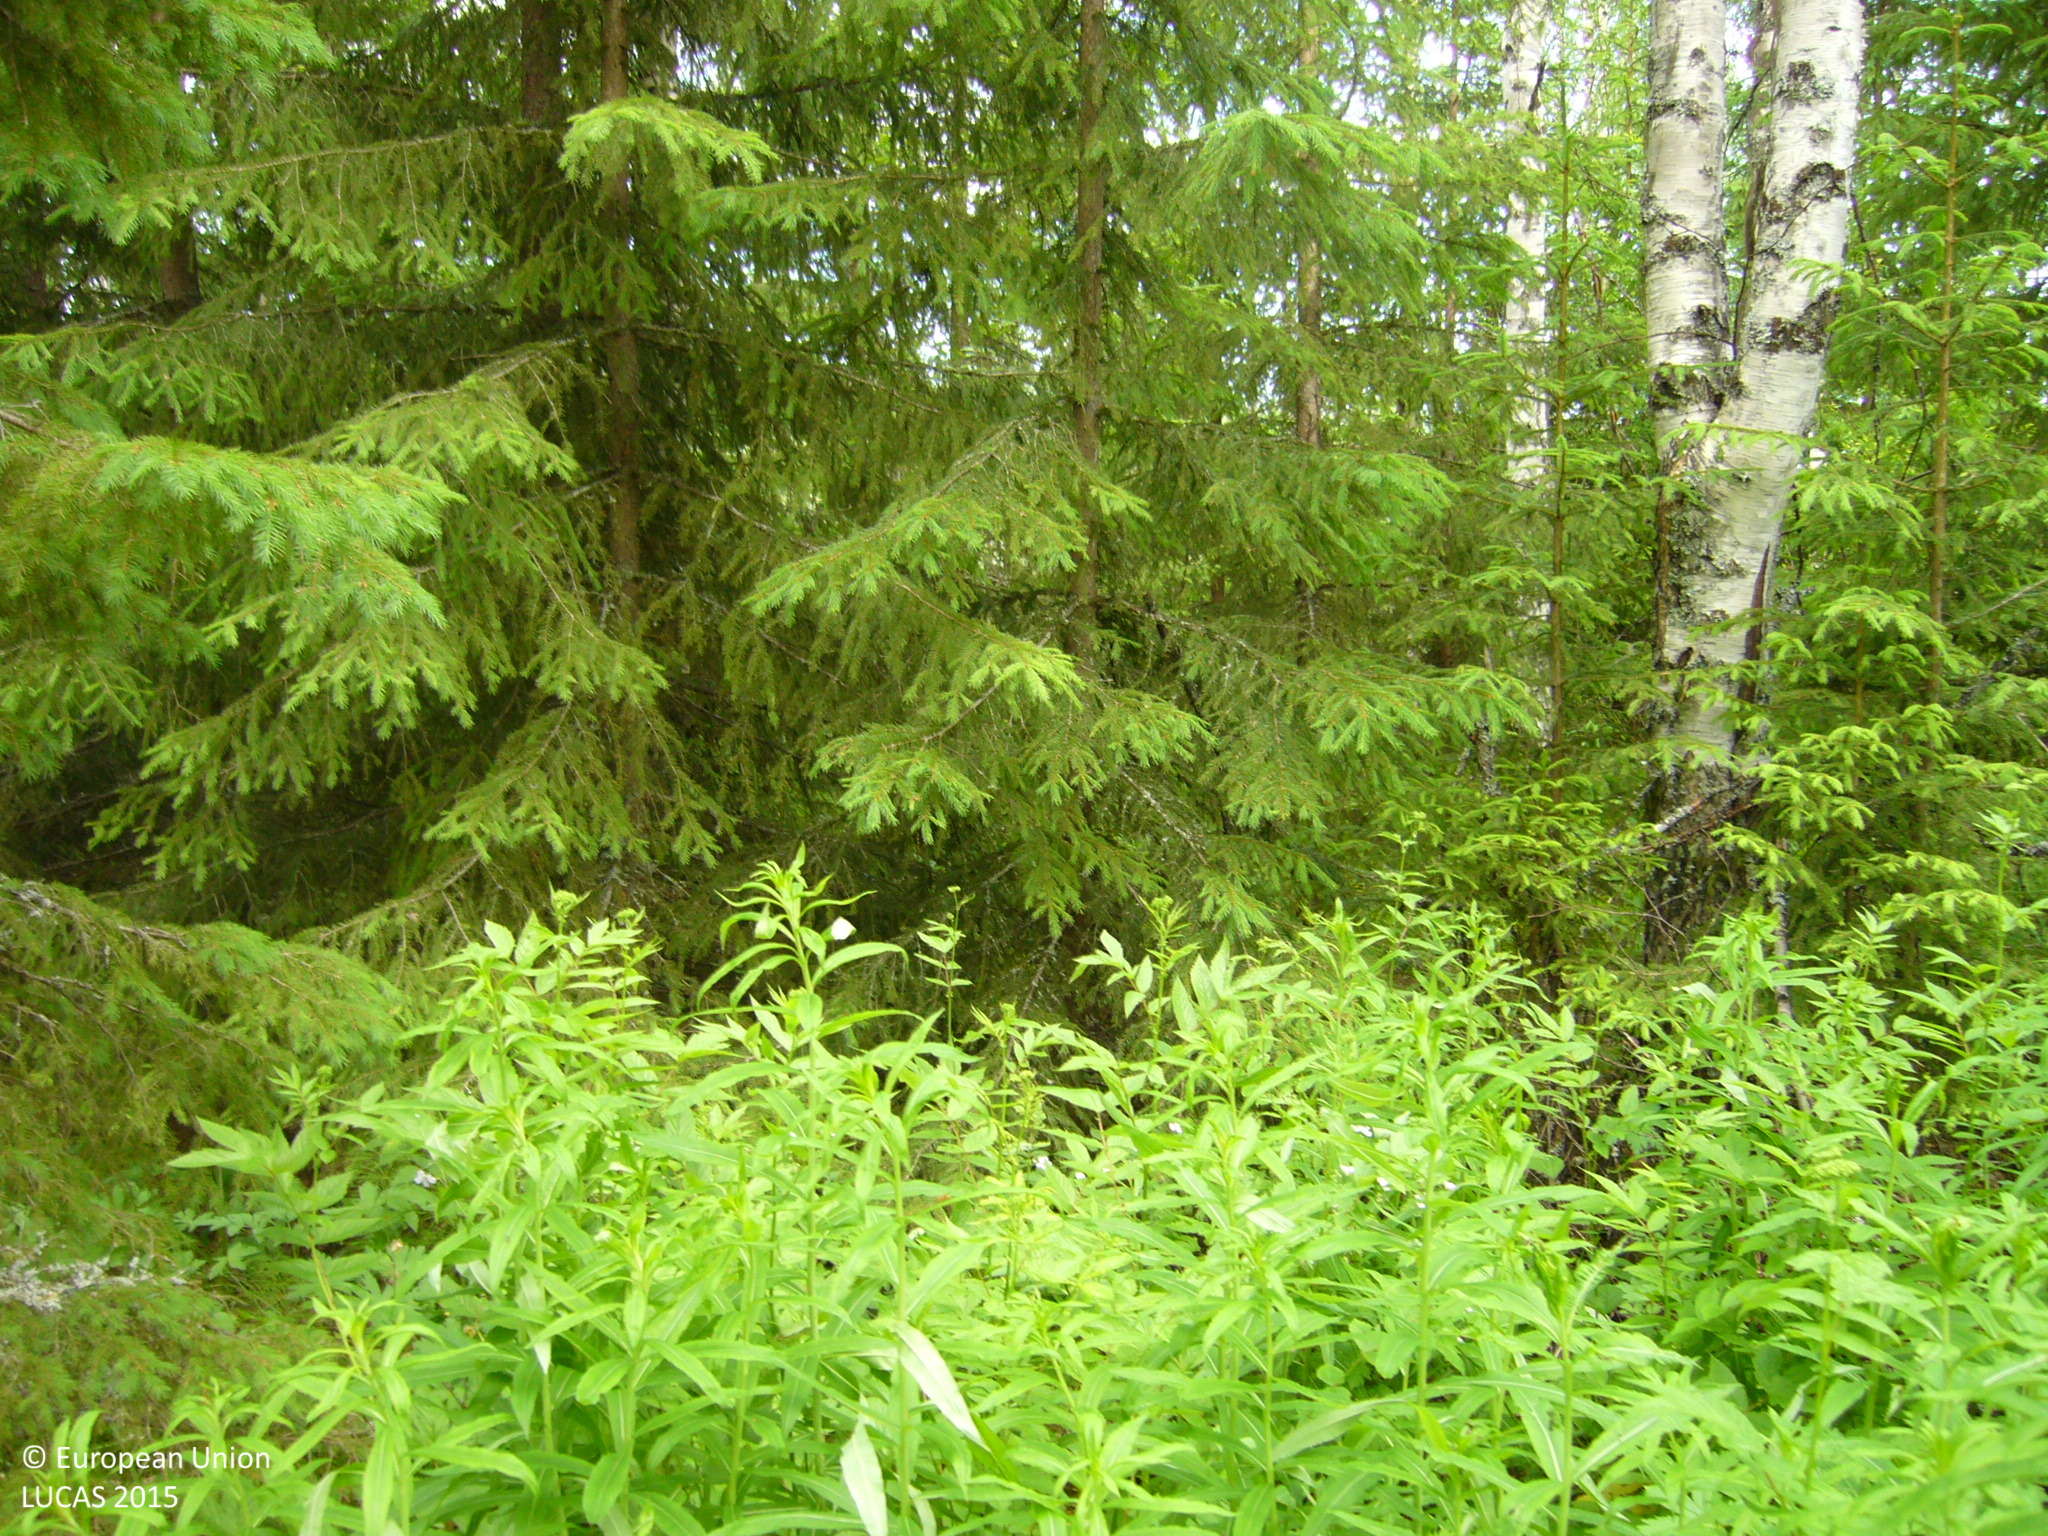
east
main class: Woodland
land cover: Spruce dominated mixed woodland
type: boreal forest
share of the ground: 50 - 75 %
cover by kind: broadleaved forest trees 40 %, coniferous forest trees 30 %, herbaceous plants 30 %
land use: Forestry
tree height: > 5 m
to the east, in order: Spruce dominated mixed woodland; Grassland with sparse tree/shrub cover; Broadleaved woodland; Spruce dominated mixed woodland; Ditches and canals; Spruce dominated mixed woodland; Ditches and canals; Spruce dominated mixed woodland
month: July
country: FI
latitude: 63.5397
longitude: 26.1904
